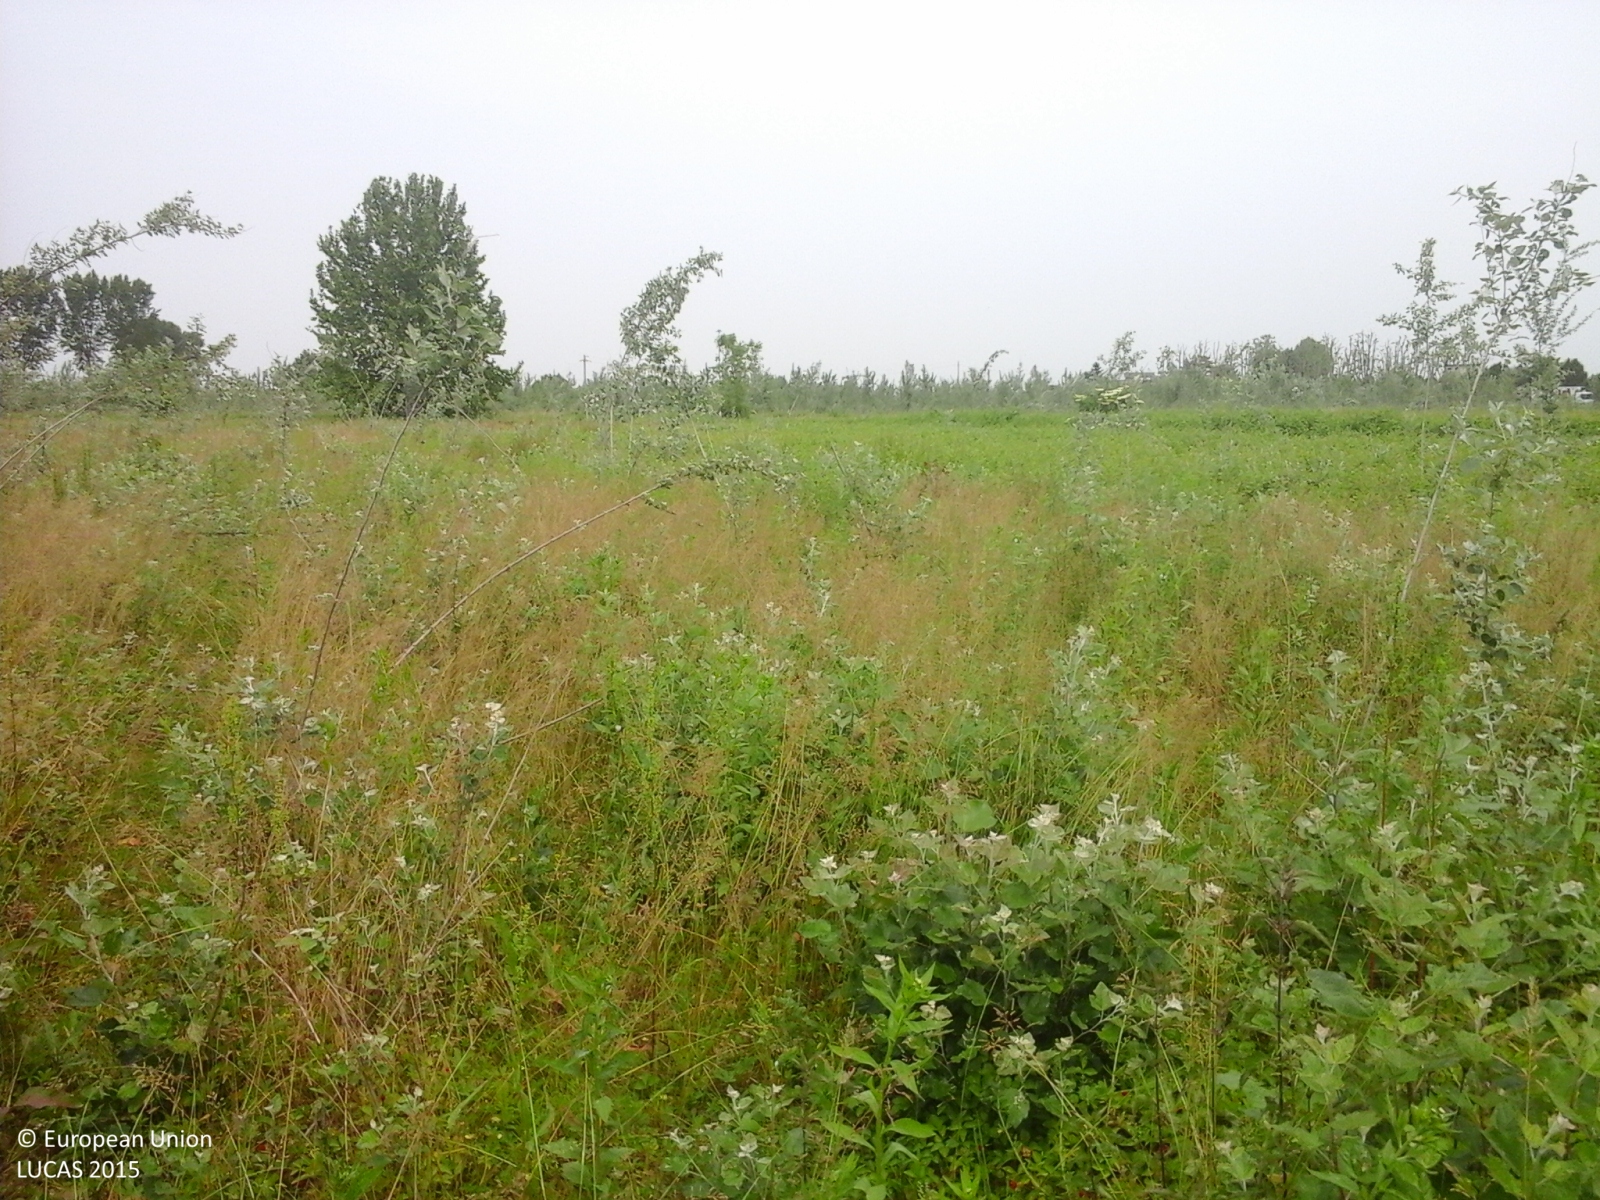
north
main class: Grassland
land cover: Grassland with sparse tree/shrub cover
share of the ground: > 75 %
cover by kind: herbaceous plants 90 %, broadleaved forest trees 5 %, shrubs 5 %
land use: Forestry
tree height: < 5 m
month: May
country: IT
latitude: 45.2863
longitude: 9.3764
